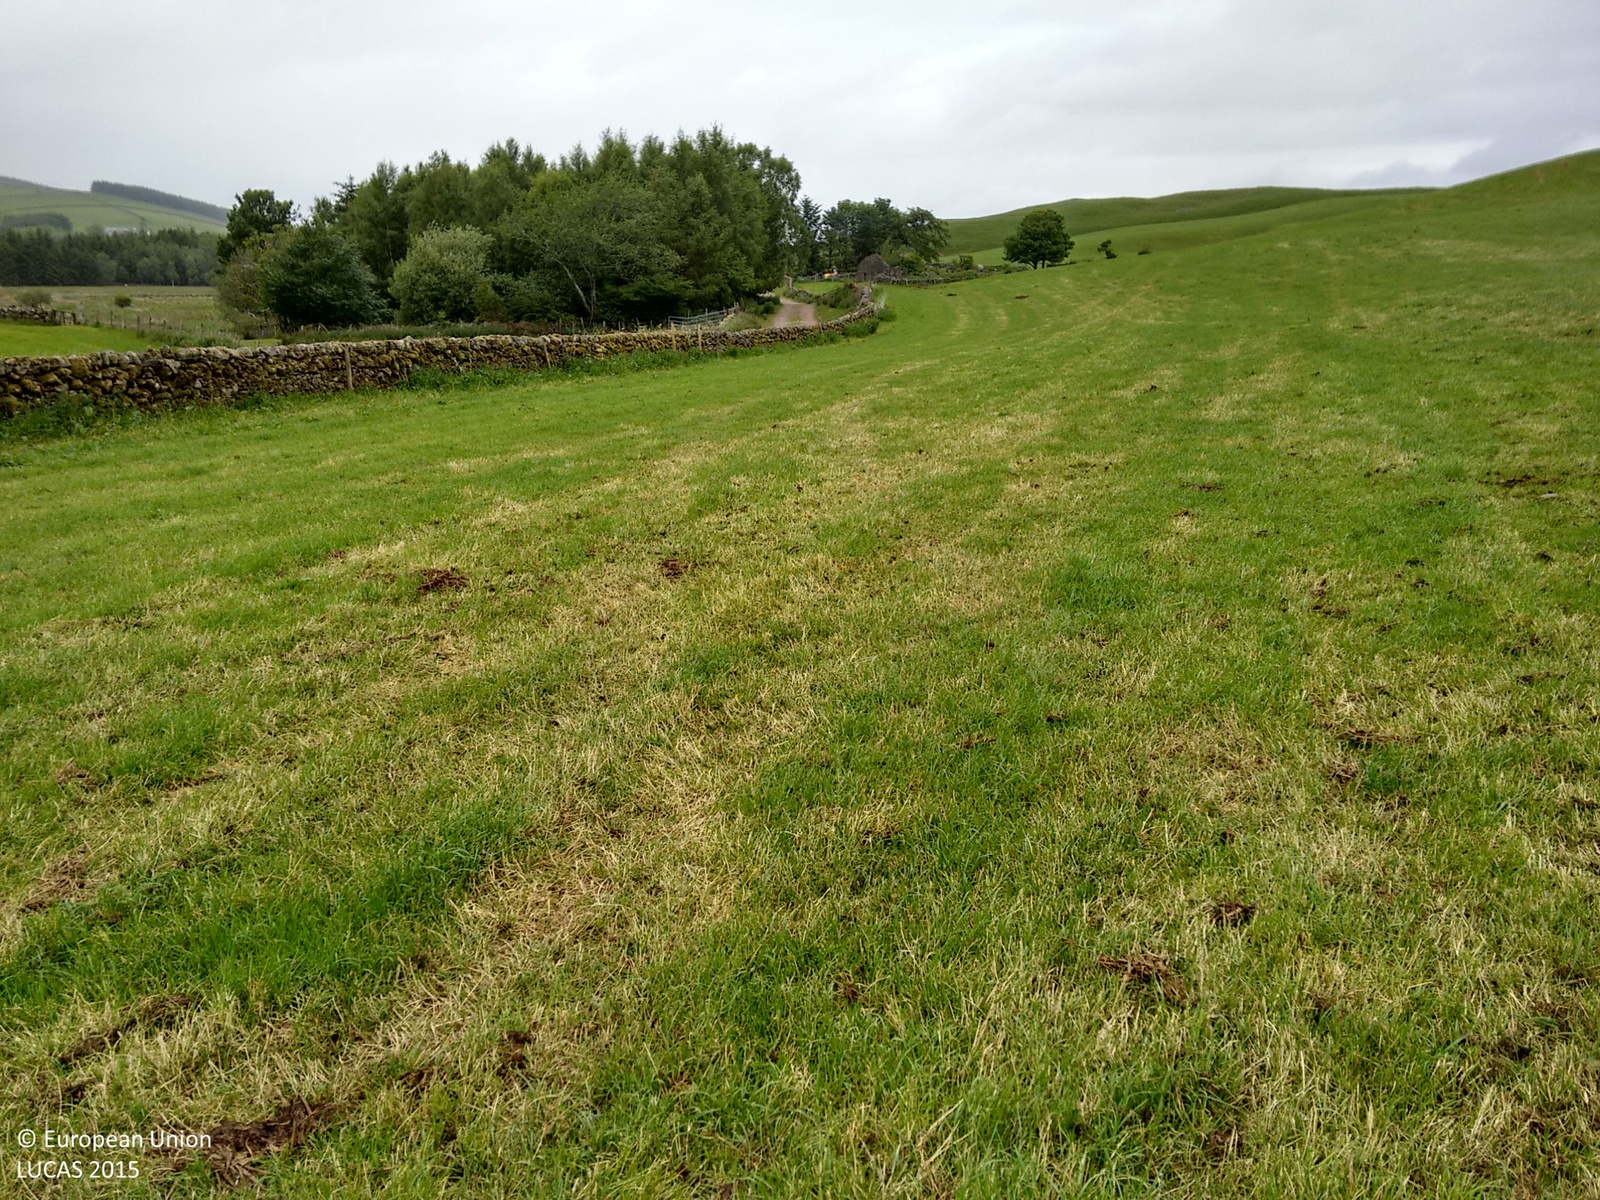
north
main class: Grassland
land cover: Grassland without tree/shrub cover
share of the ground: > 75 %
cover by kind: herbaceous plants 80 %, unconsolidated bare surface 20 %
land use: Agriculture (excluding fallow land and kitchen gardens)
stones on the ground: < 10 %
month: June
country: GB
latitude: 55.1677
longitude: -3.7588
